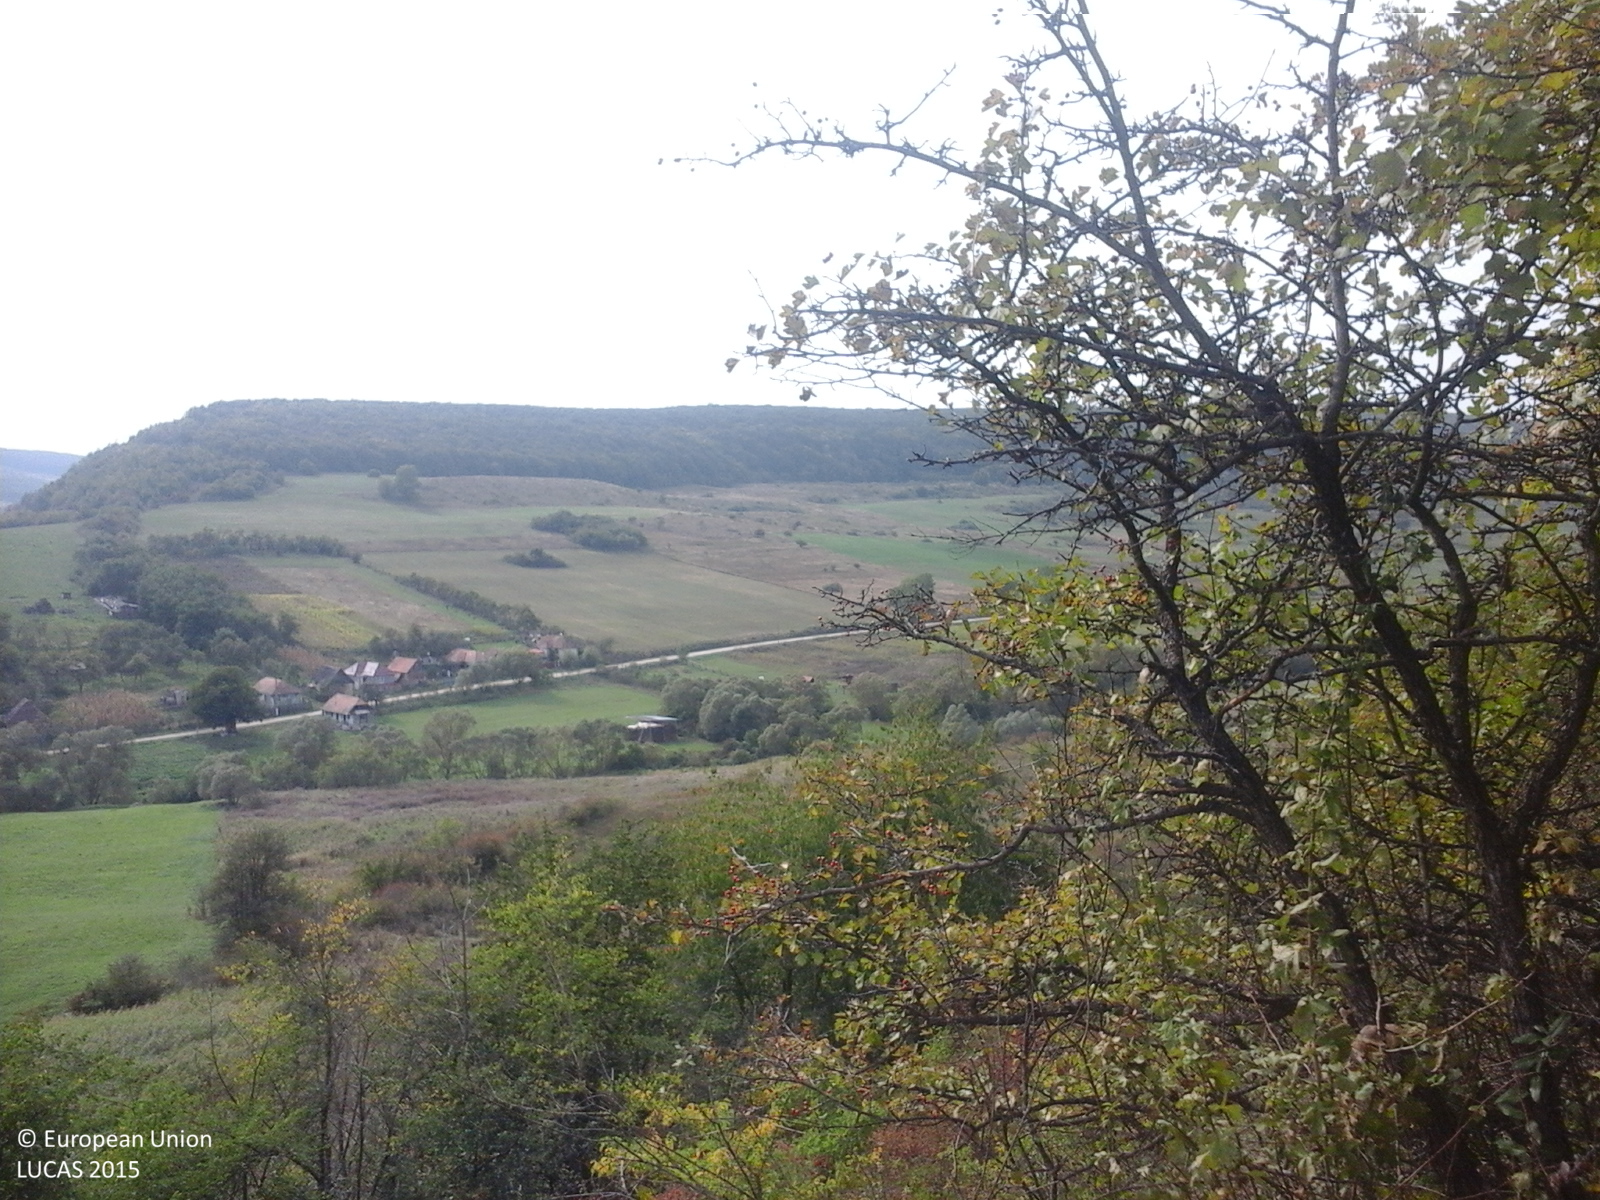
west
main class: Shrubland
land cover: Shrubland with sparse tree cover
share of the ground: > 75 %
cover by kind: herbaceous plants 85 %, shrubs 10 %, broadleaved forest trees 5 %
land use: Fallow land
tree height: < 5 m
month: September
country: RO
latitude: 46.9536
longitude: 23.6198
